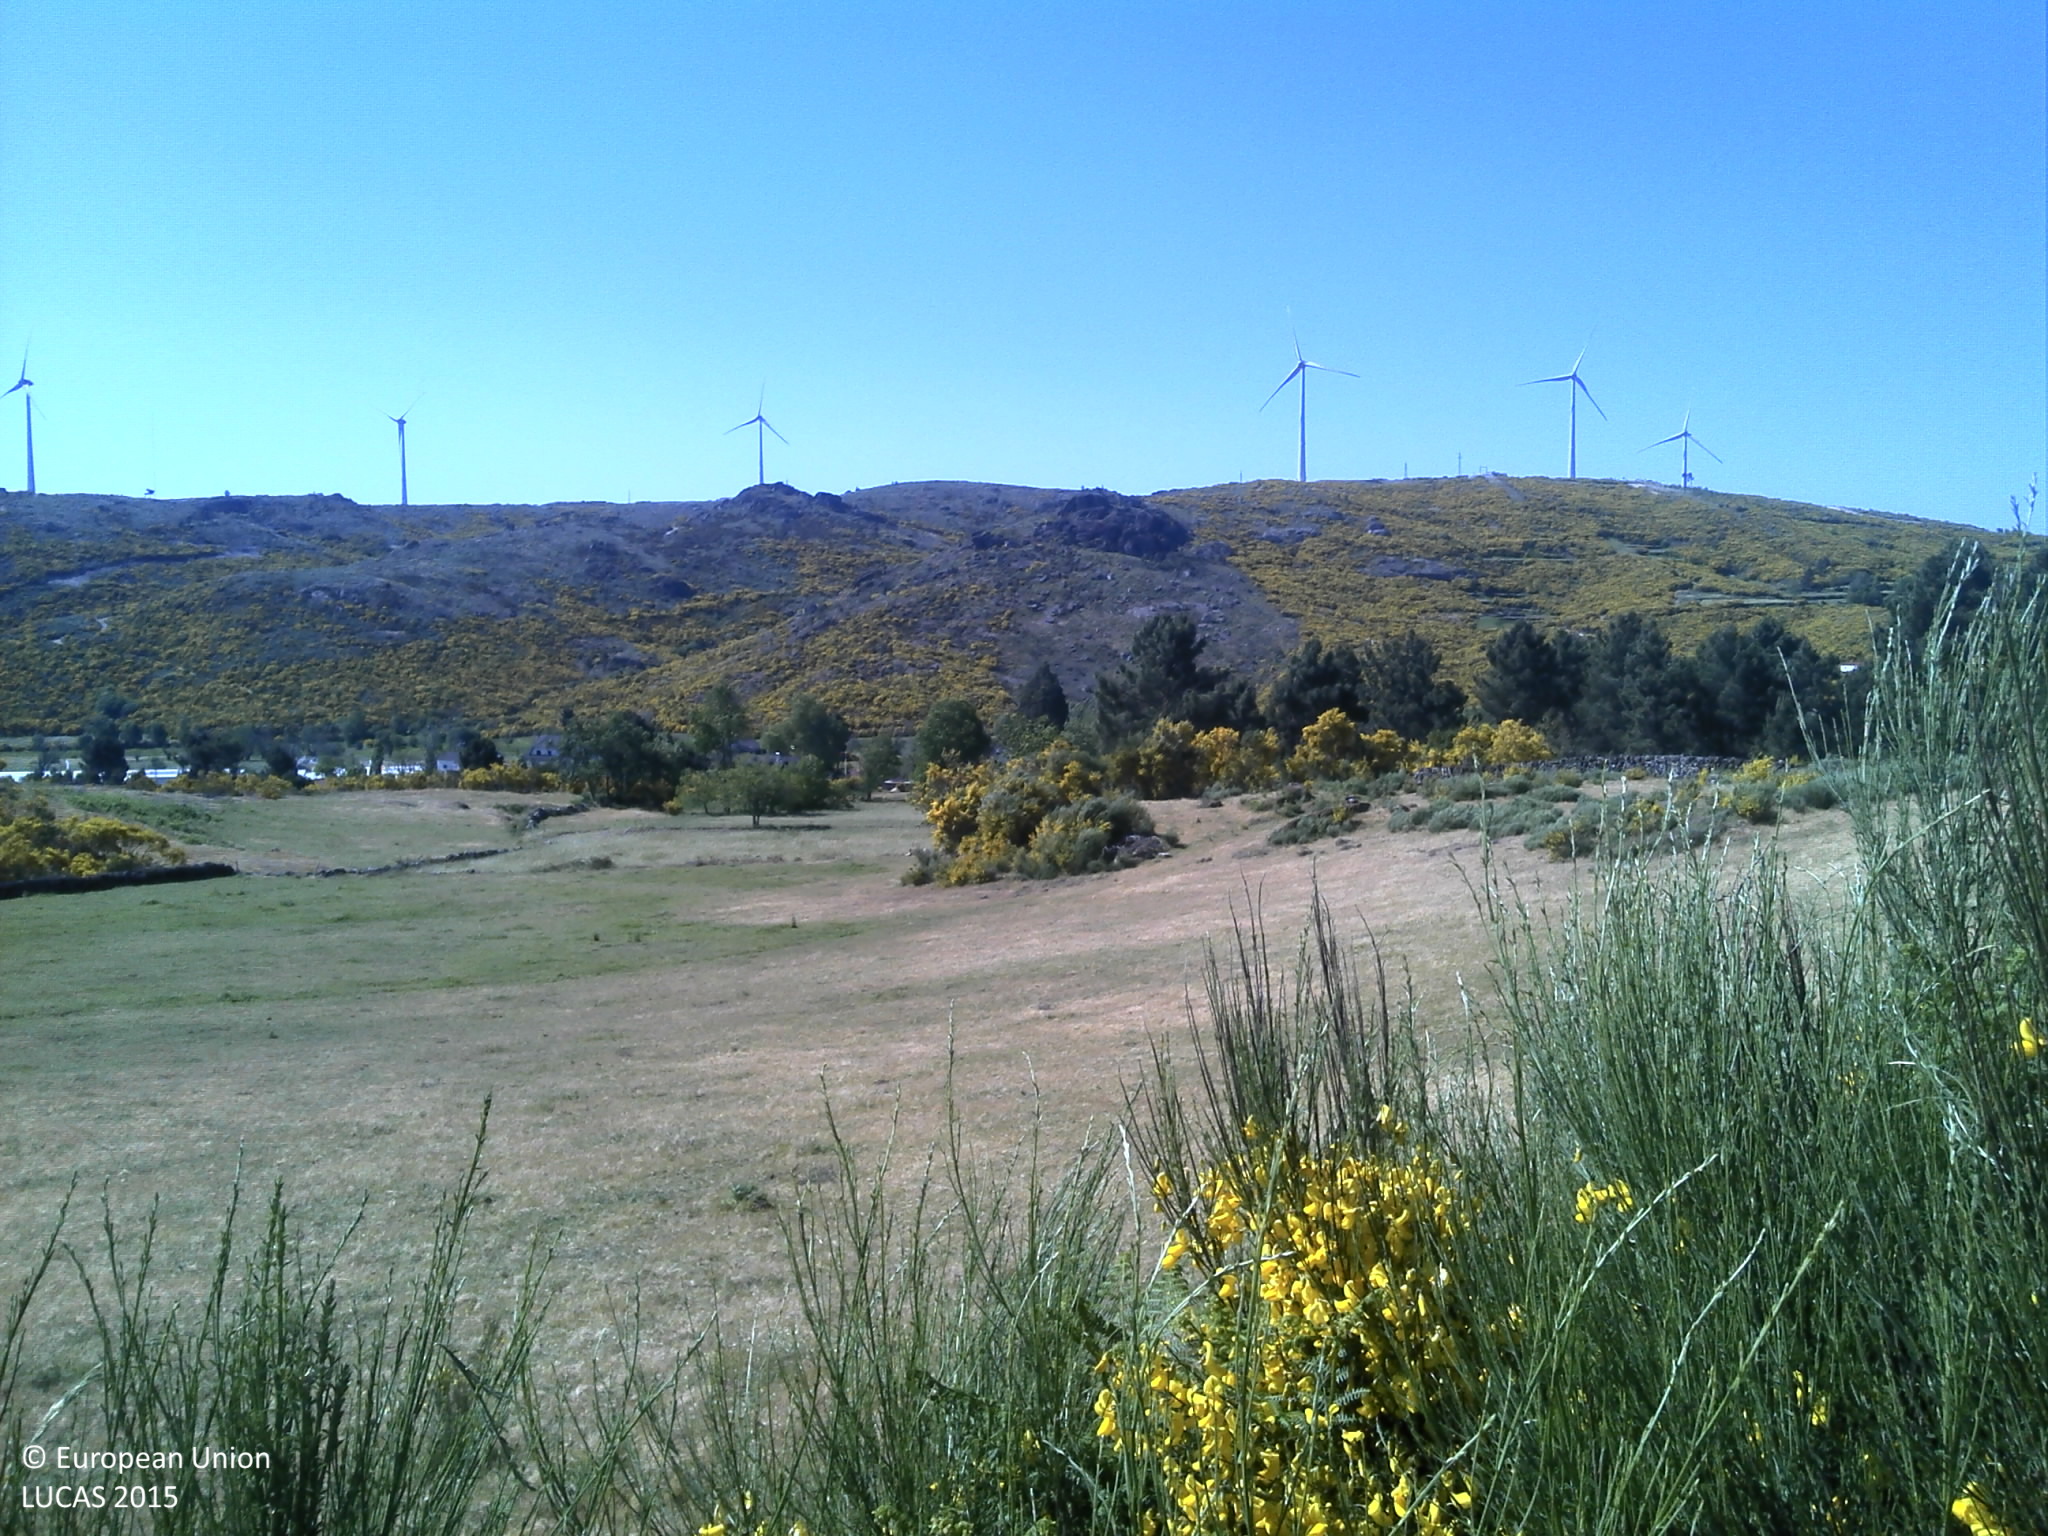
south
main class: Shrubland
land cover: Shrubland without tree cover
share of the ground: 25 - 50 %
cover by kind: shrubs 75 %, unconsolidated bare surface 20 %, herbaceous plants 5 %
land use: Agriculture (excluding fallow land and kitchen gardens)
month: May
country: PT
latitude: 40.5067
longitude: -7.3001
